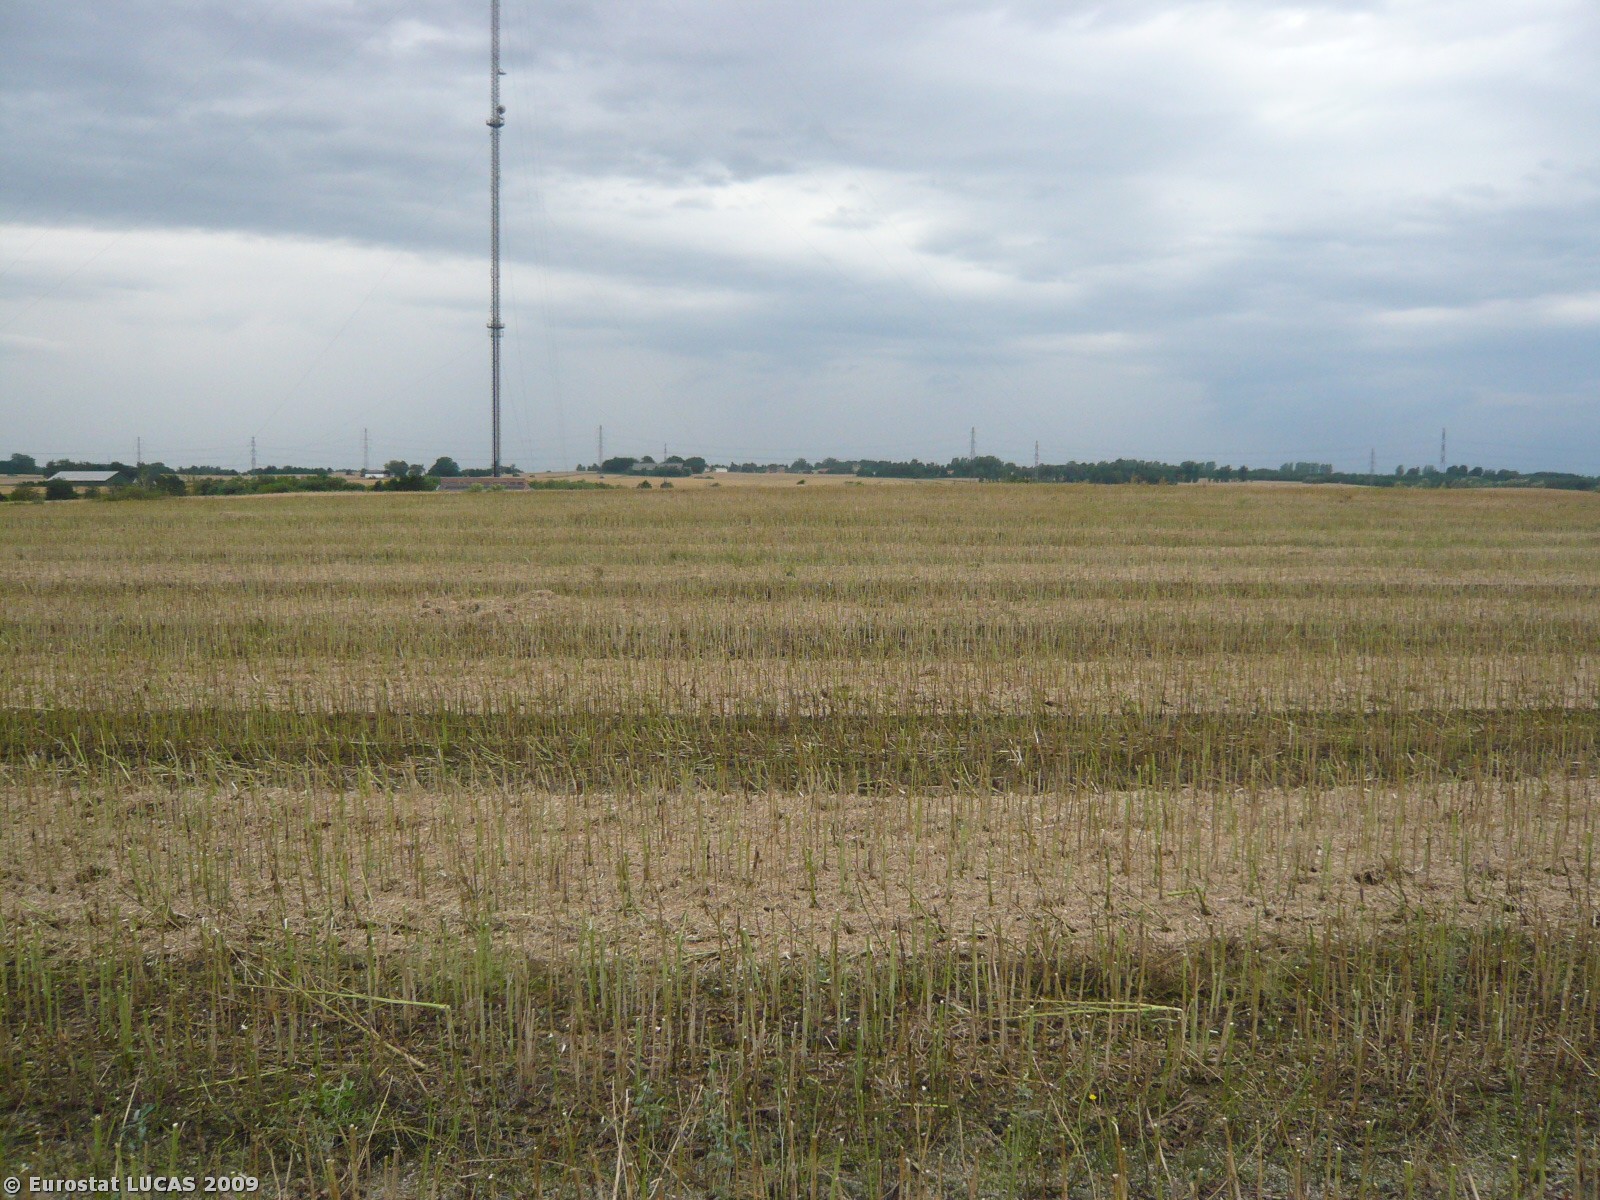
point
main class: Cropland
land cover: Rape and turnip rape
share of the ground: < 10 %
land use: Agriculture (excluding fallow land and kitchen gardens)
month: July
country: DK
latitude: 55.7186
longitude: 12.2427
